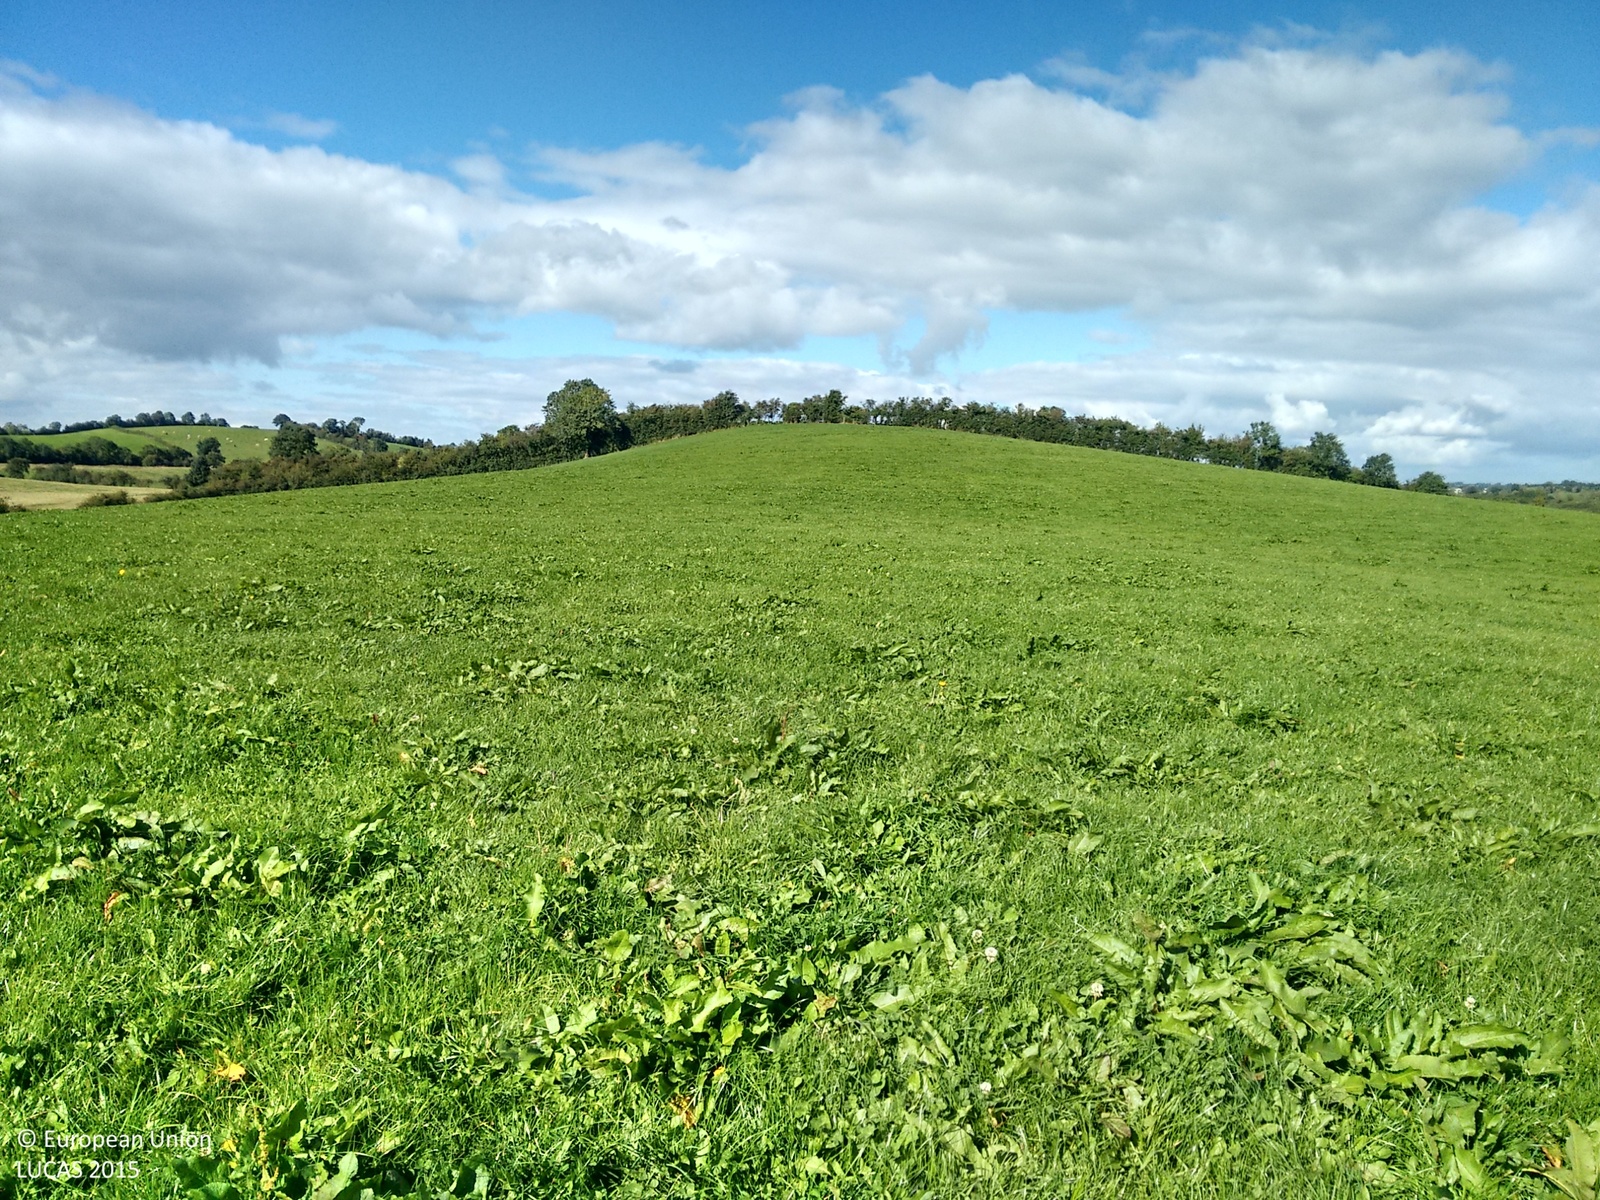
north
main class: Grassland
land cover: Grassland without tree/shrub cover
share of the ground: > 75 %
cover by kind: herbaceous plants 100 %
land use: Agriculture (excluding fallow land and kitchen gardens)
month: September
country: IE
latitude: 54.2467
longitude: -6.8796
